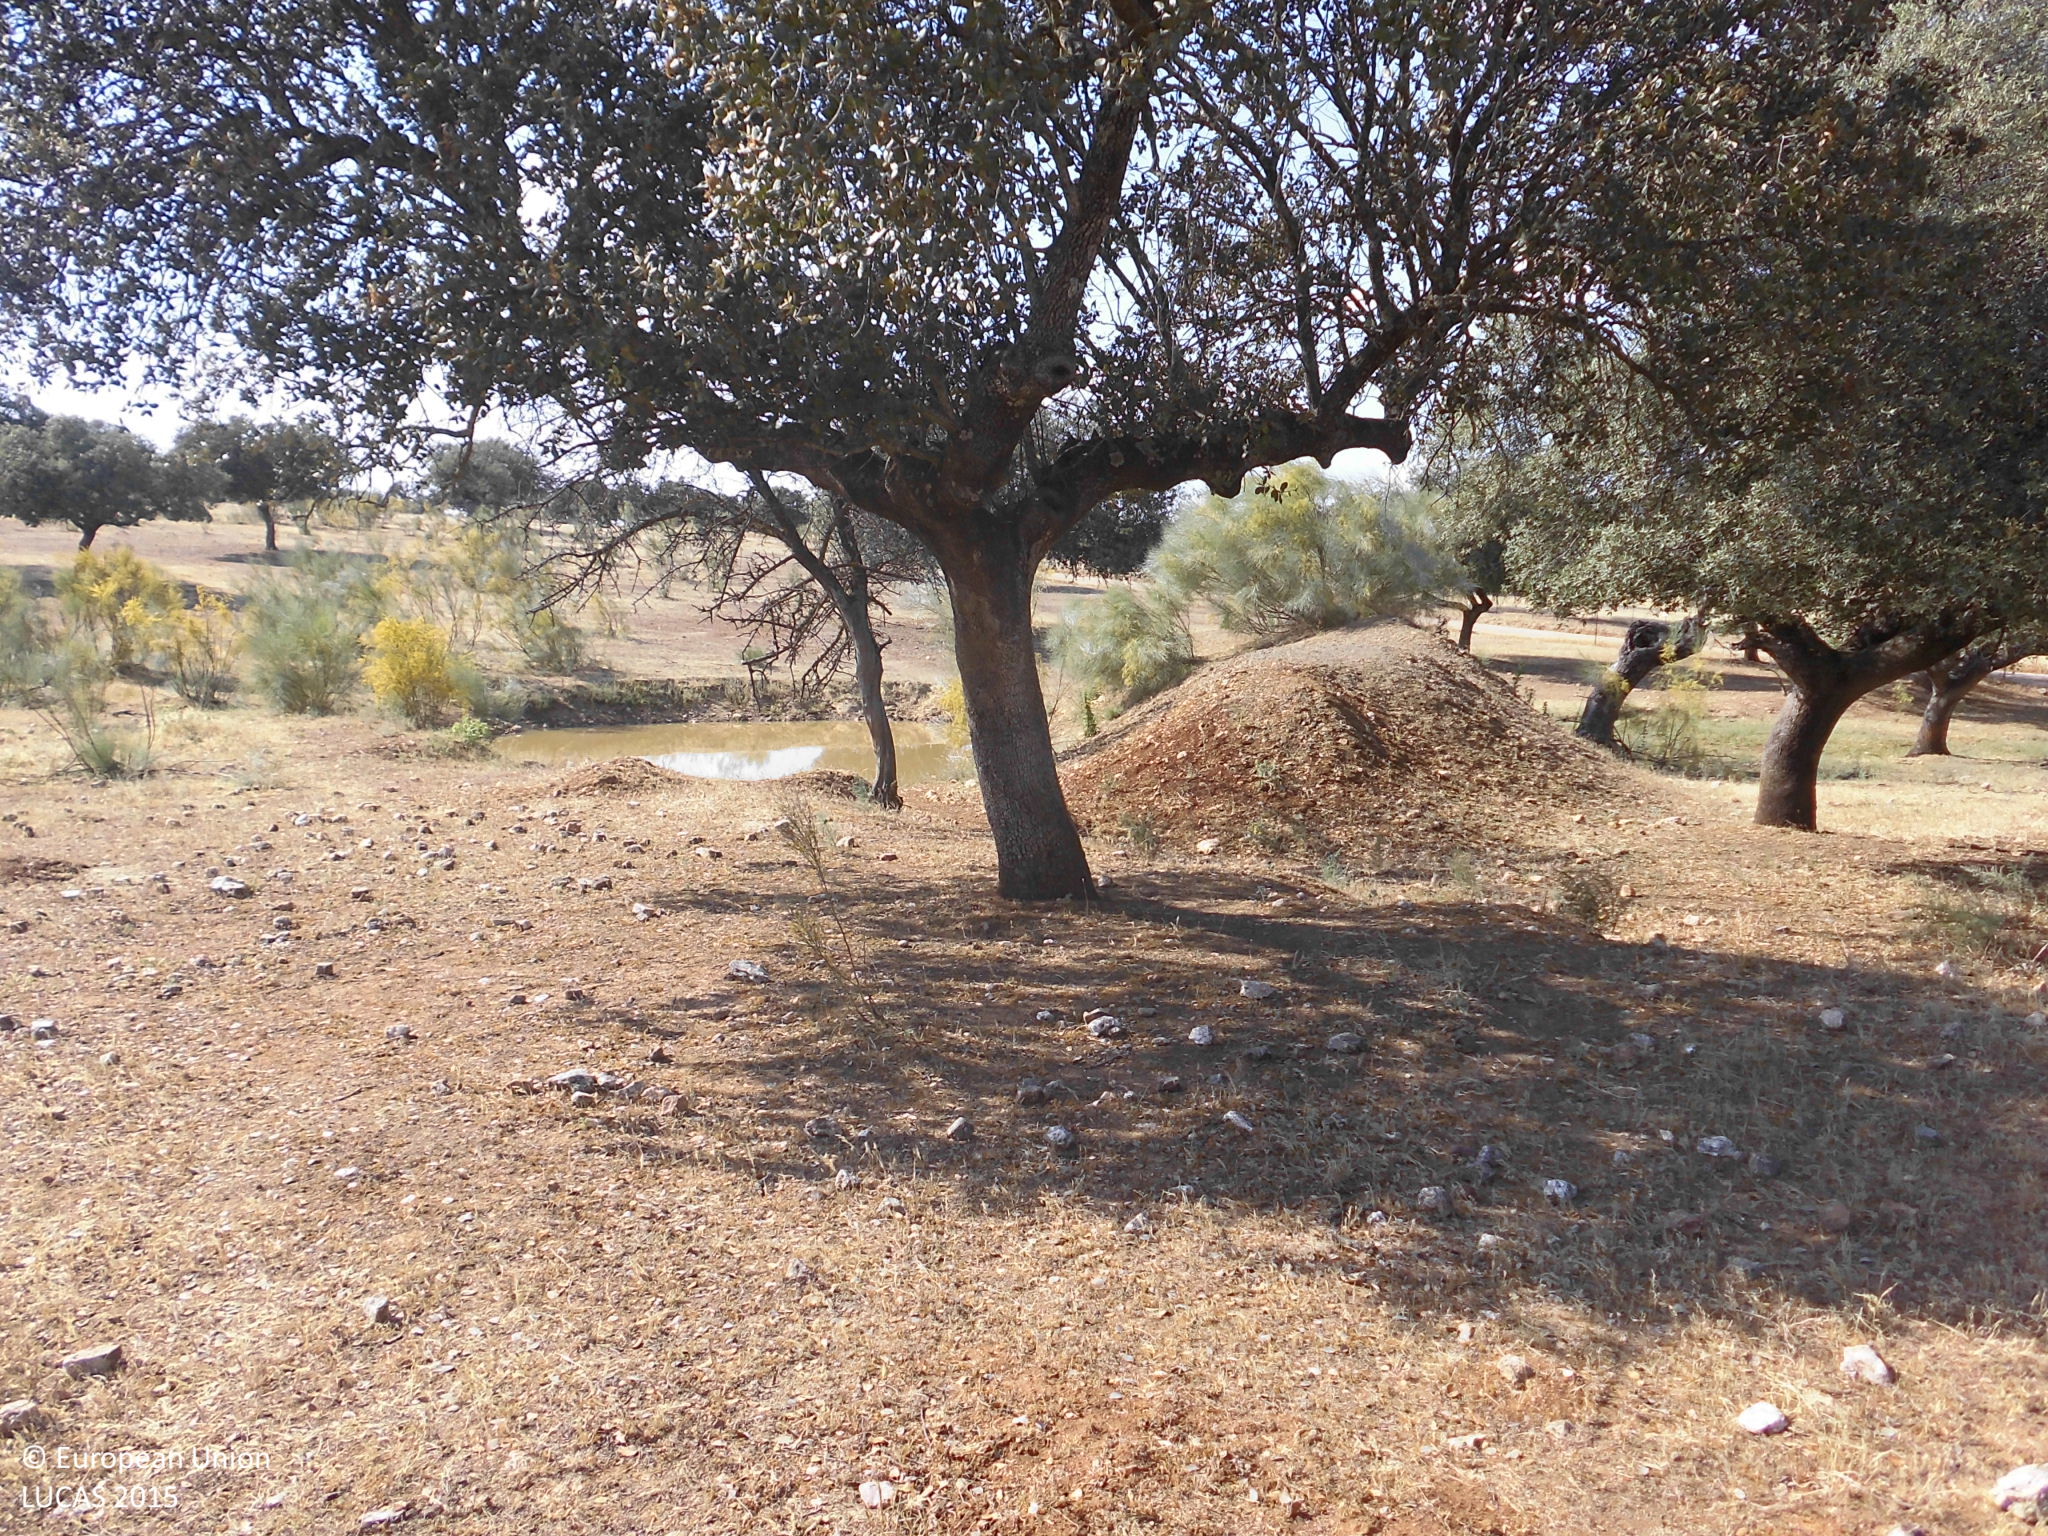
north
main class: Woodland
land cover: Broadleaved woodland
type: broadleaved evergreen forest
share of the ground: 25 - 50 %
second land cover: Grassland without tree/shrub cover
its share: > 75 %
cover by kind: herbaceous plants 55 %, broadleaved forest trees 35 %, shrubs 5 %
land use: Forestry
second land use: Agriculture (excluding fallow land and kitchen gardens)
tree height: > 5 m
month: May
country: ES
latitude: 39.6877
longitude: -6.5037
